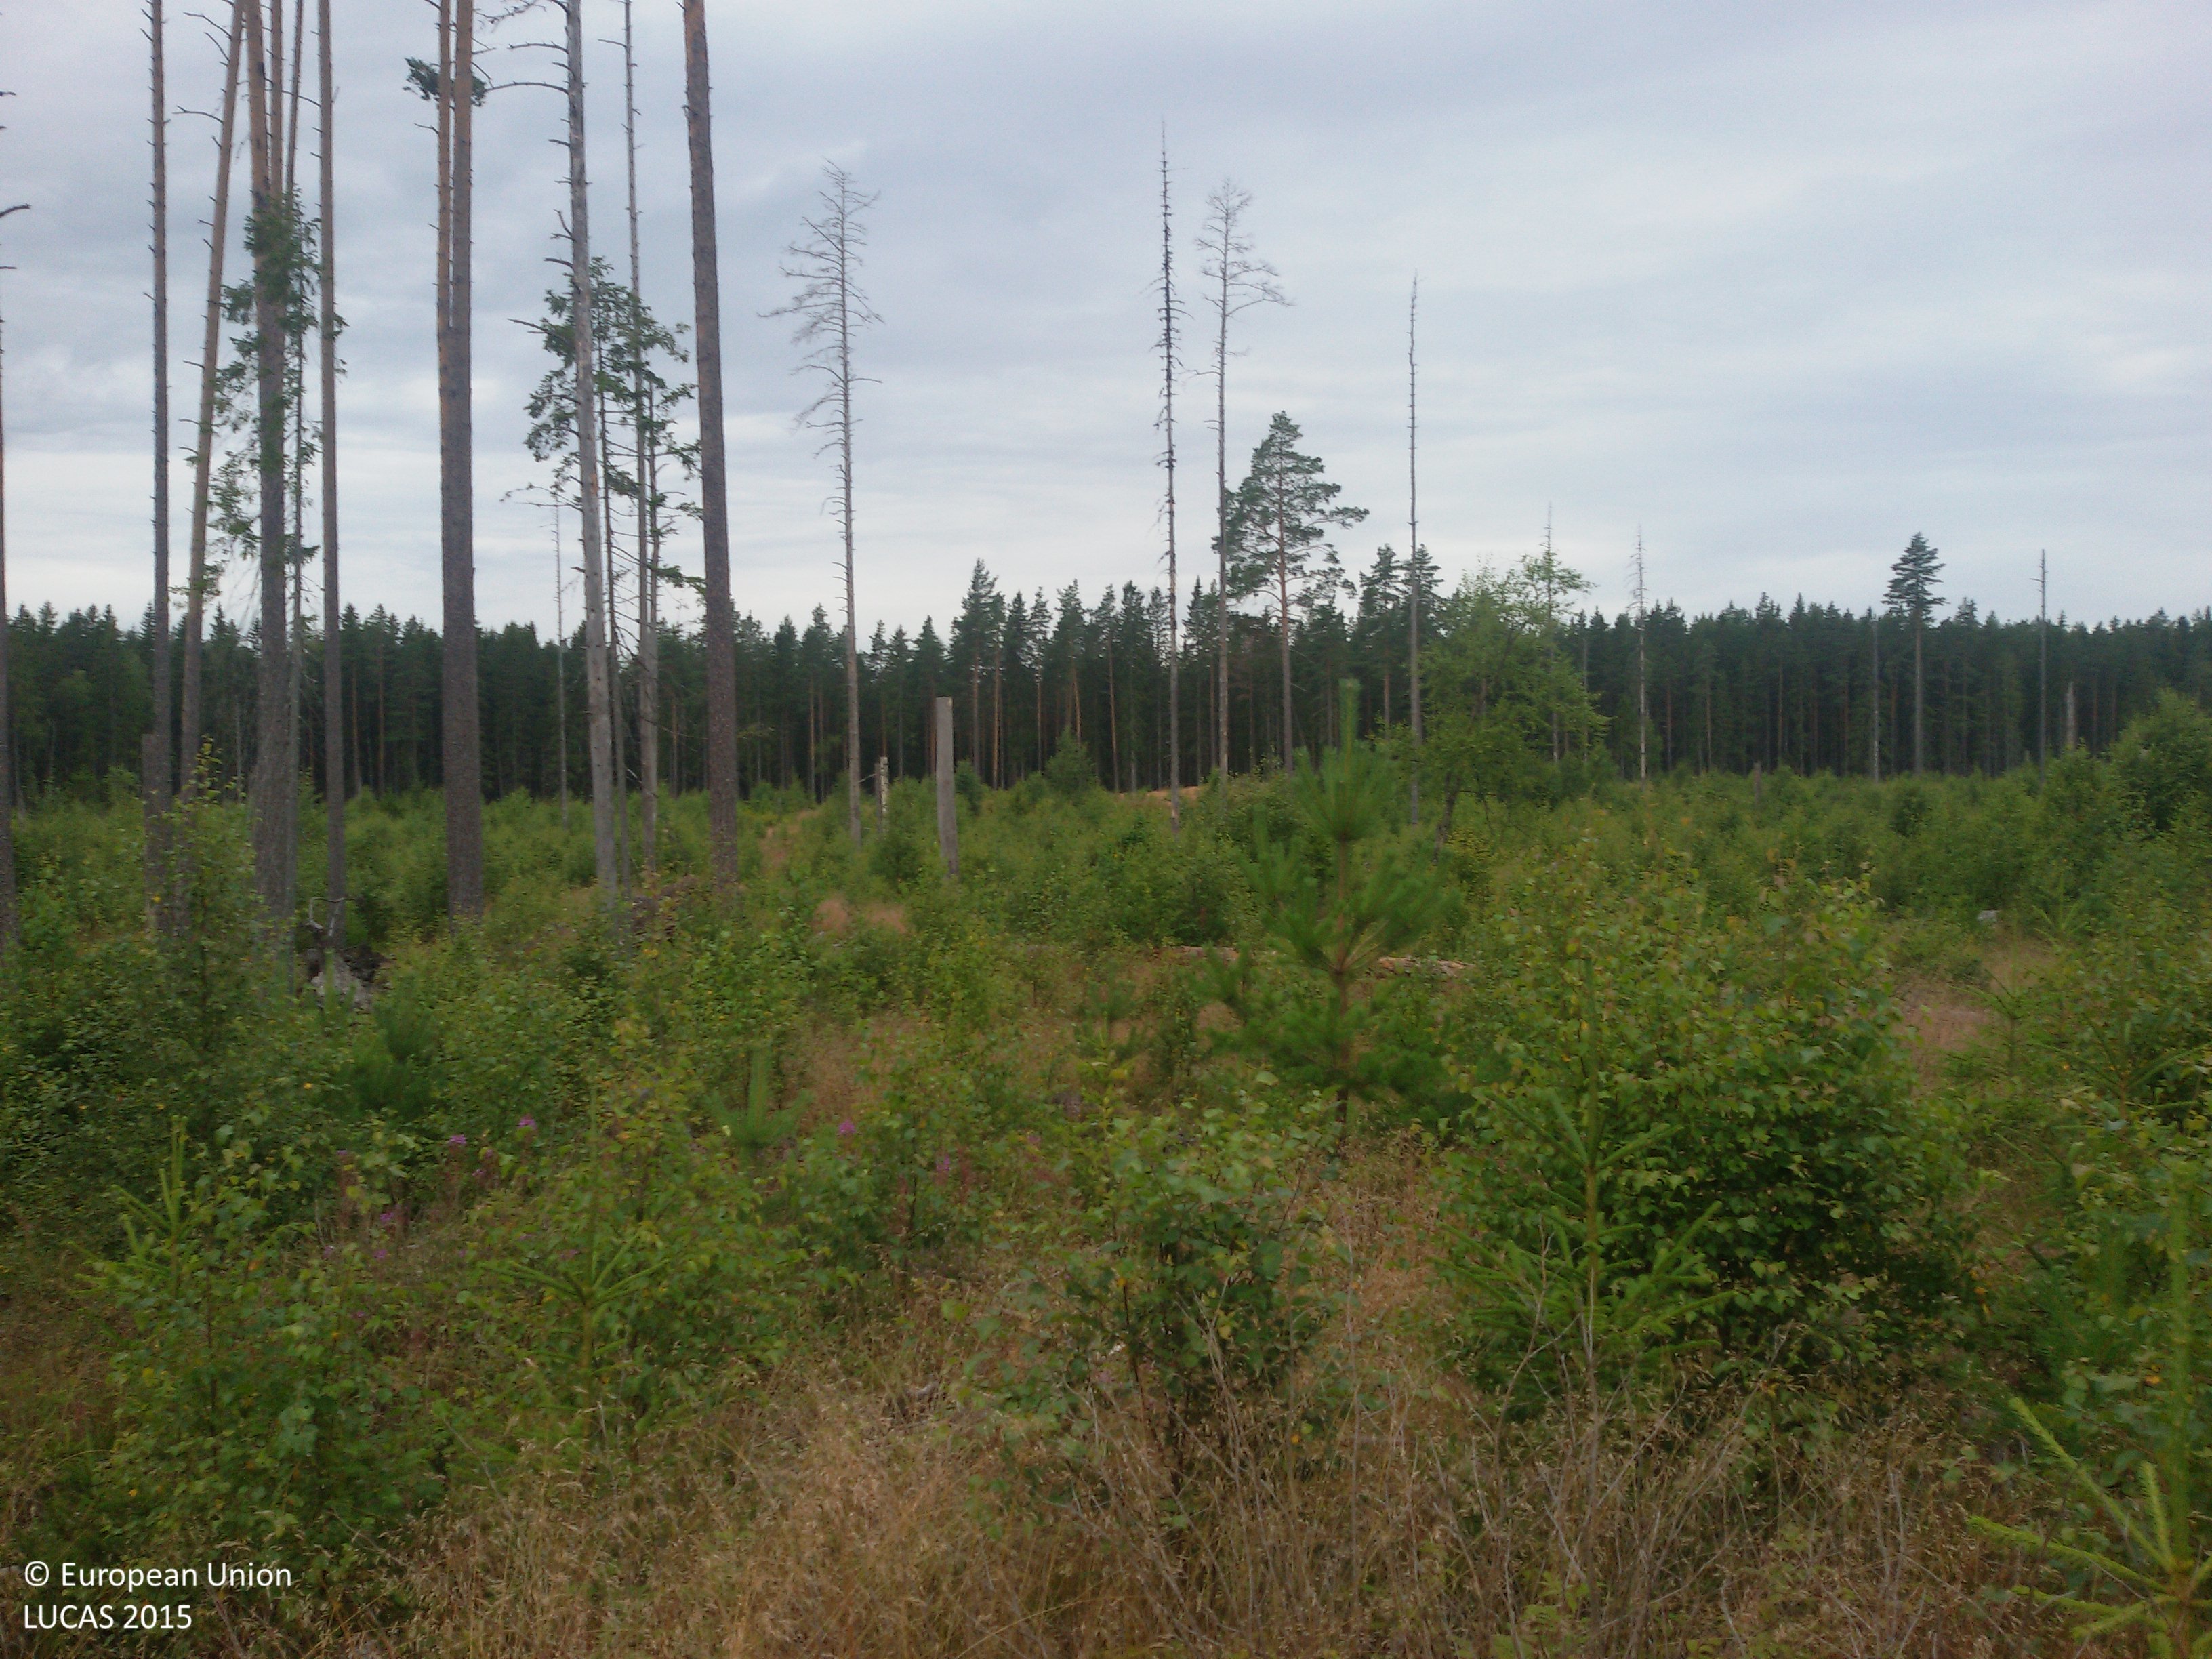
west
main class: Woodland
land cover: Pine dominated mixed woodland
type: boreal forest
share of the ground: 50 - 75 %
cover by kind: broadleaved forest trees 40 %, coniferous forest trees 30 %, shrubs 15 %, herbaceous plants 15 %
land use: Forestry
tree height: < 5 m
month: August
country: SE
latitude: 60.6379
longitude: 16.6616
